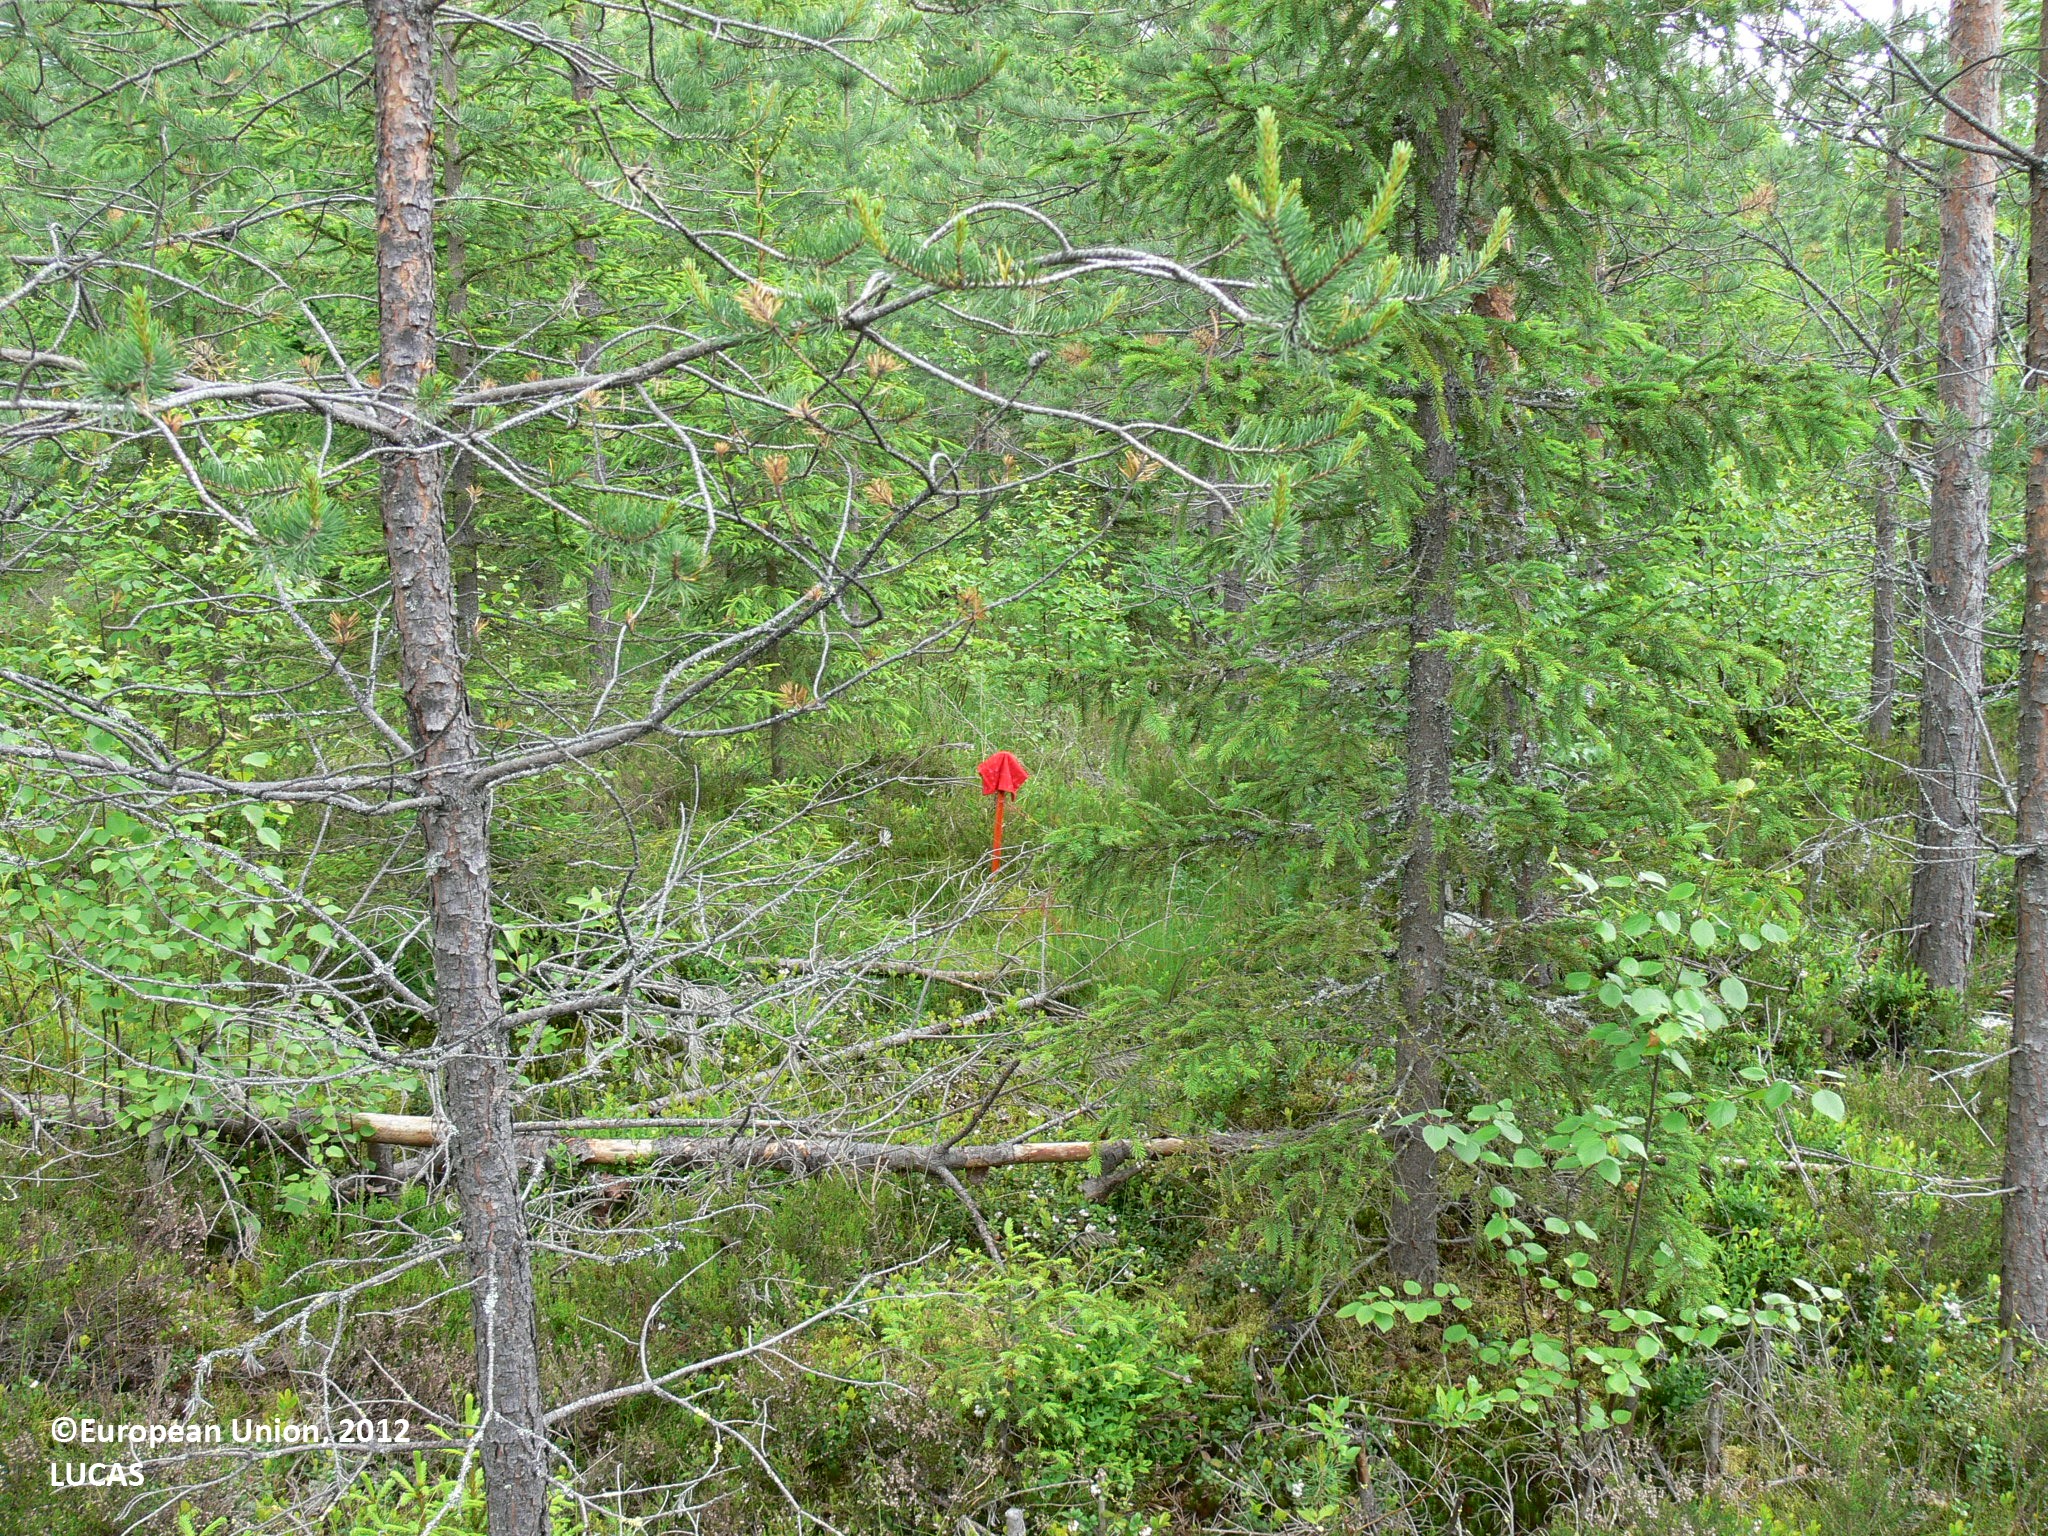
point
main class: Woodland
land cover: Other coniferous woodland
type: boreal forest
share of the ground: > 75 %
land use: Forestry
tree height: < 5 m
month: June
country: FI
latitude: 62.7302
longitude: 30.6522
